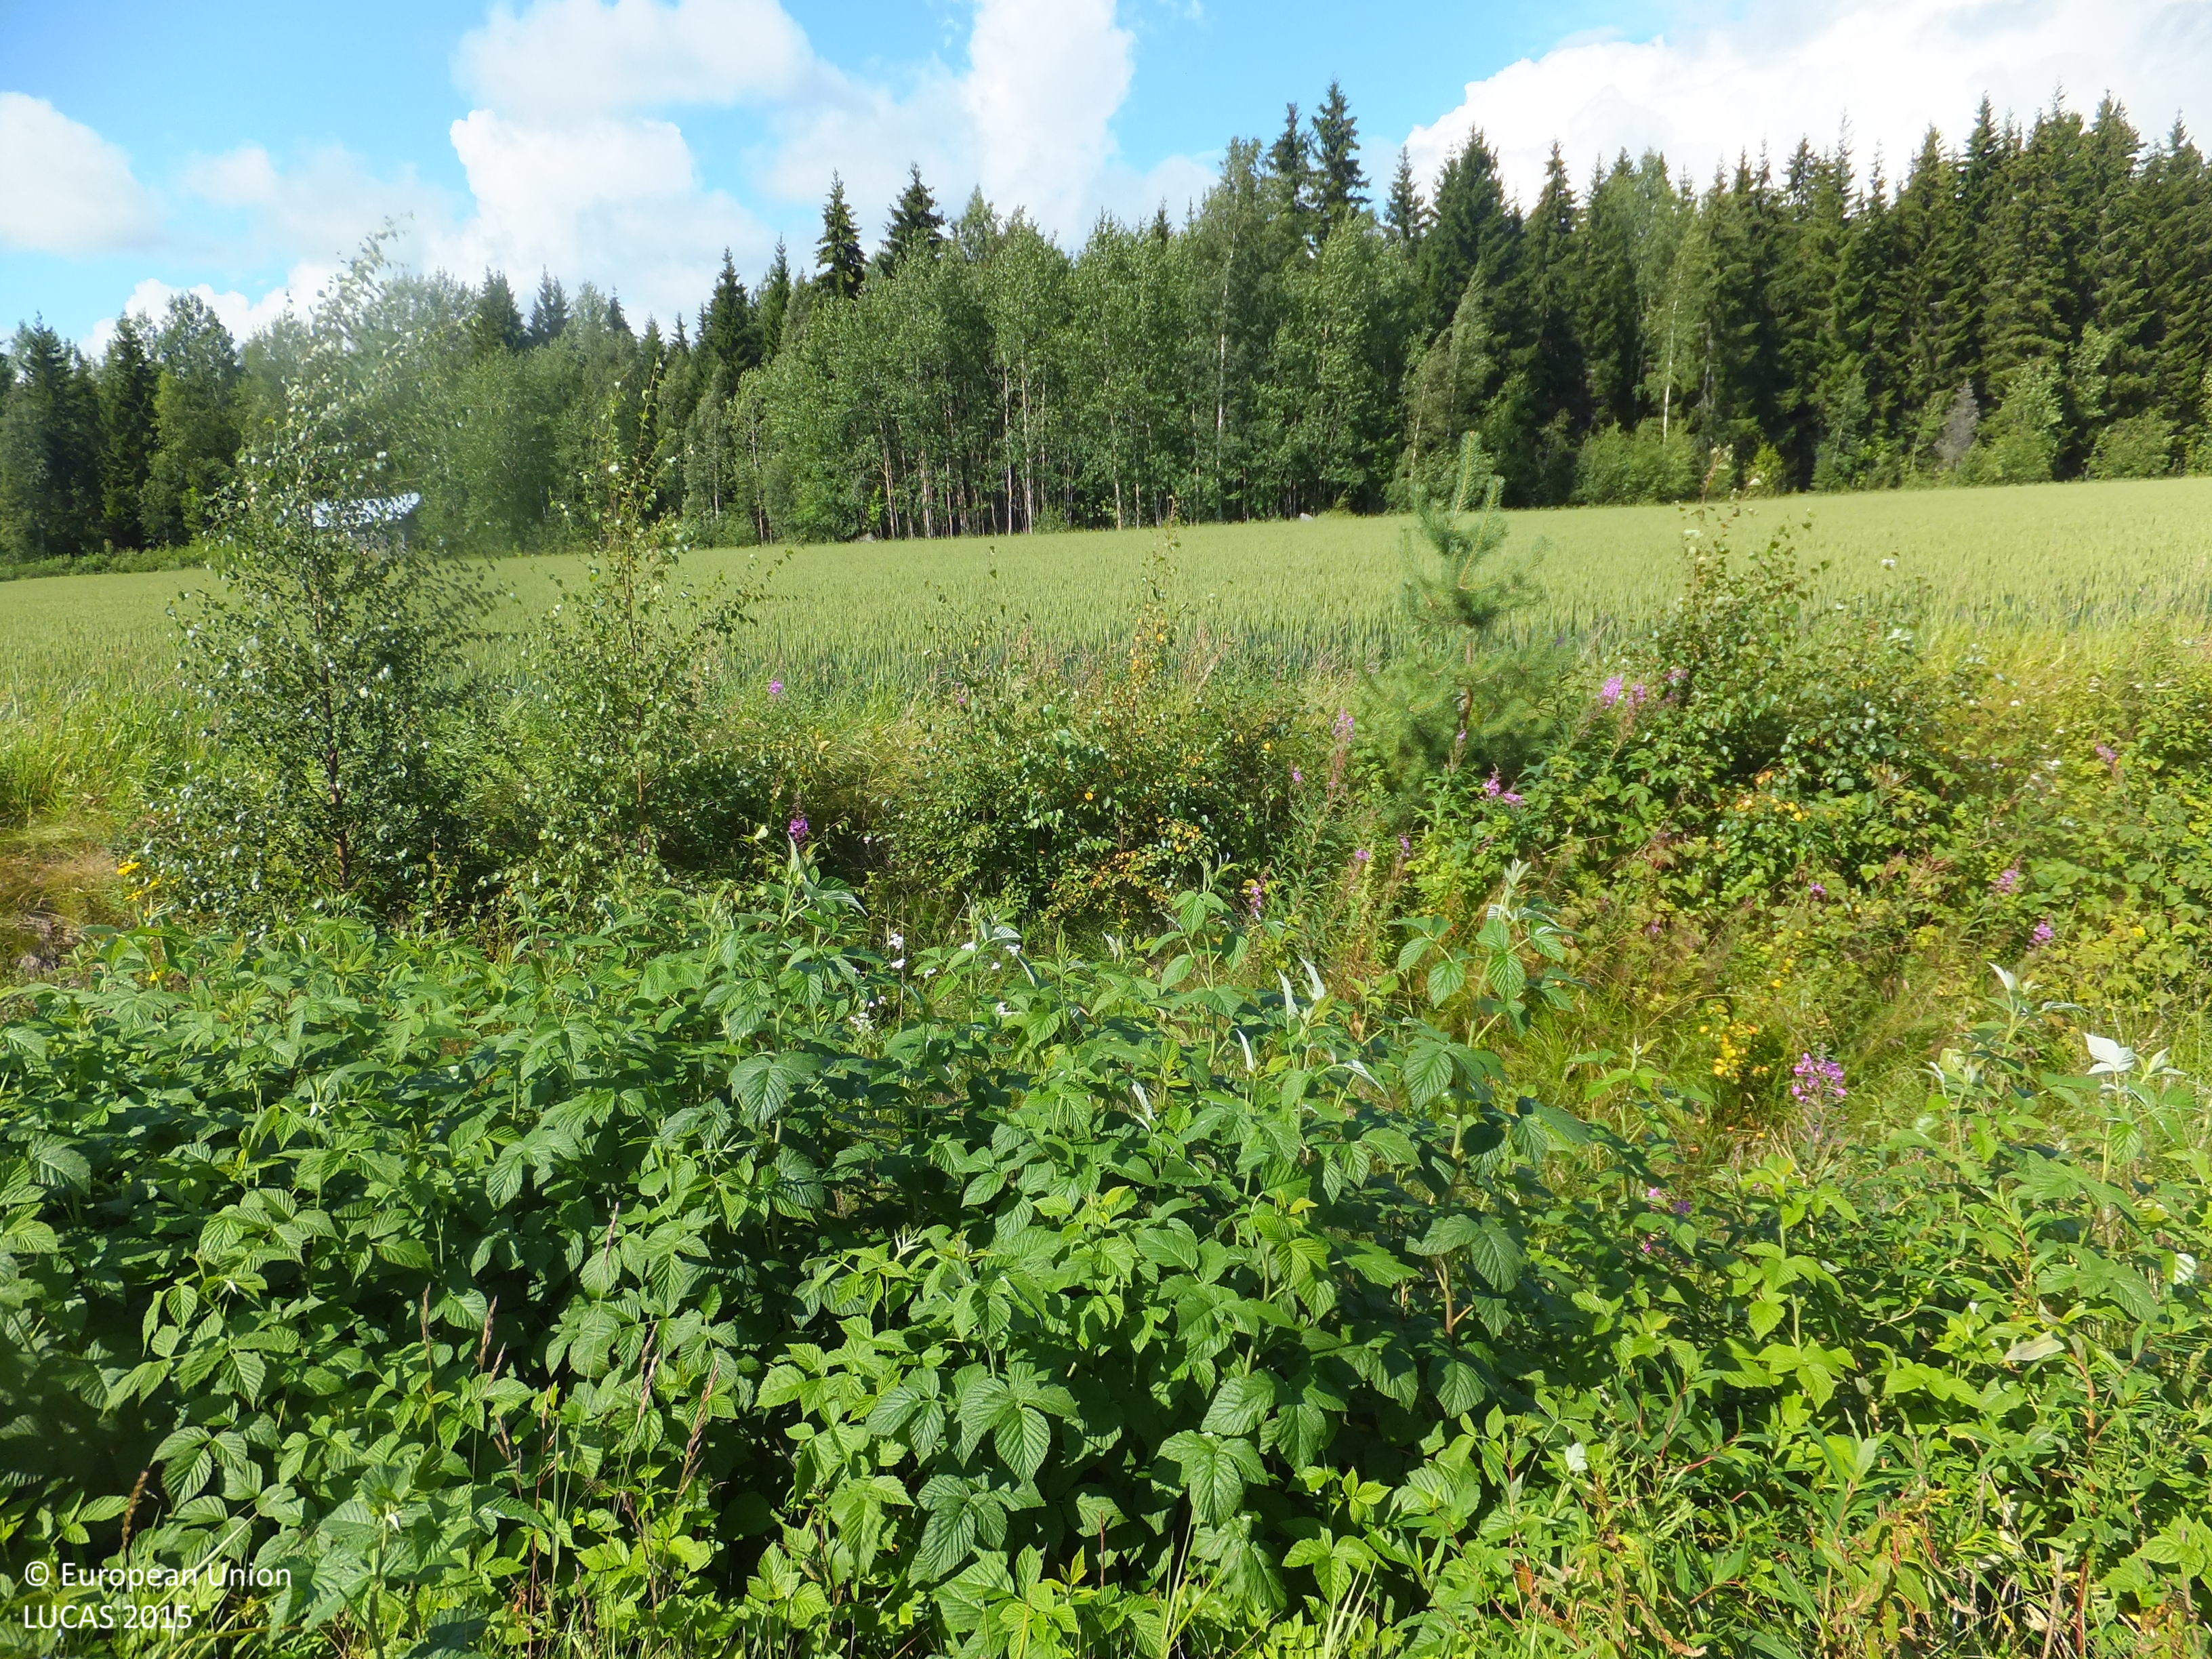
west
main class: Cropland
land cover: Common wheat
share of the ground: > 75 %
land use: Agriculture (excluding fallow land and kitchen gardens)
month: July
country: FI
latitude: 63.0285
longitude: 22.2017
